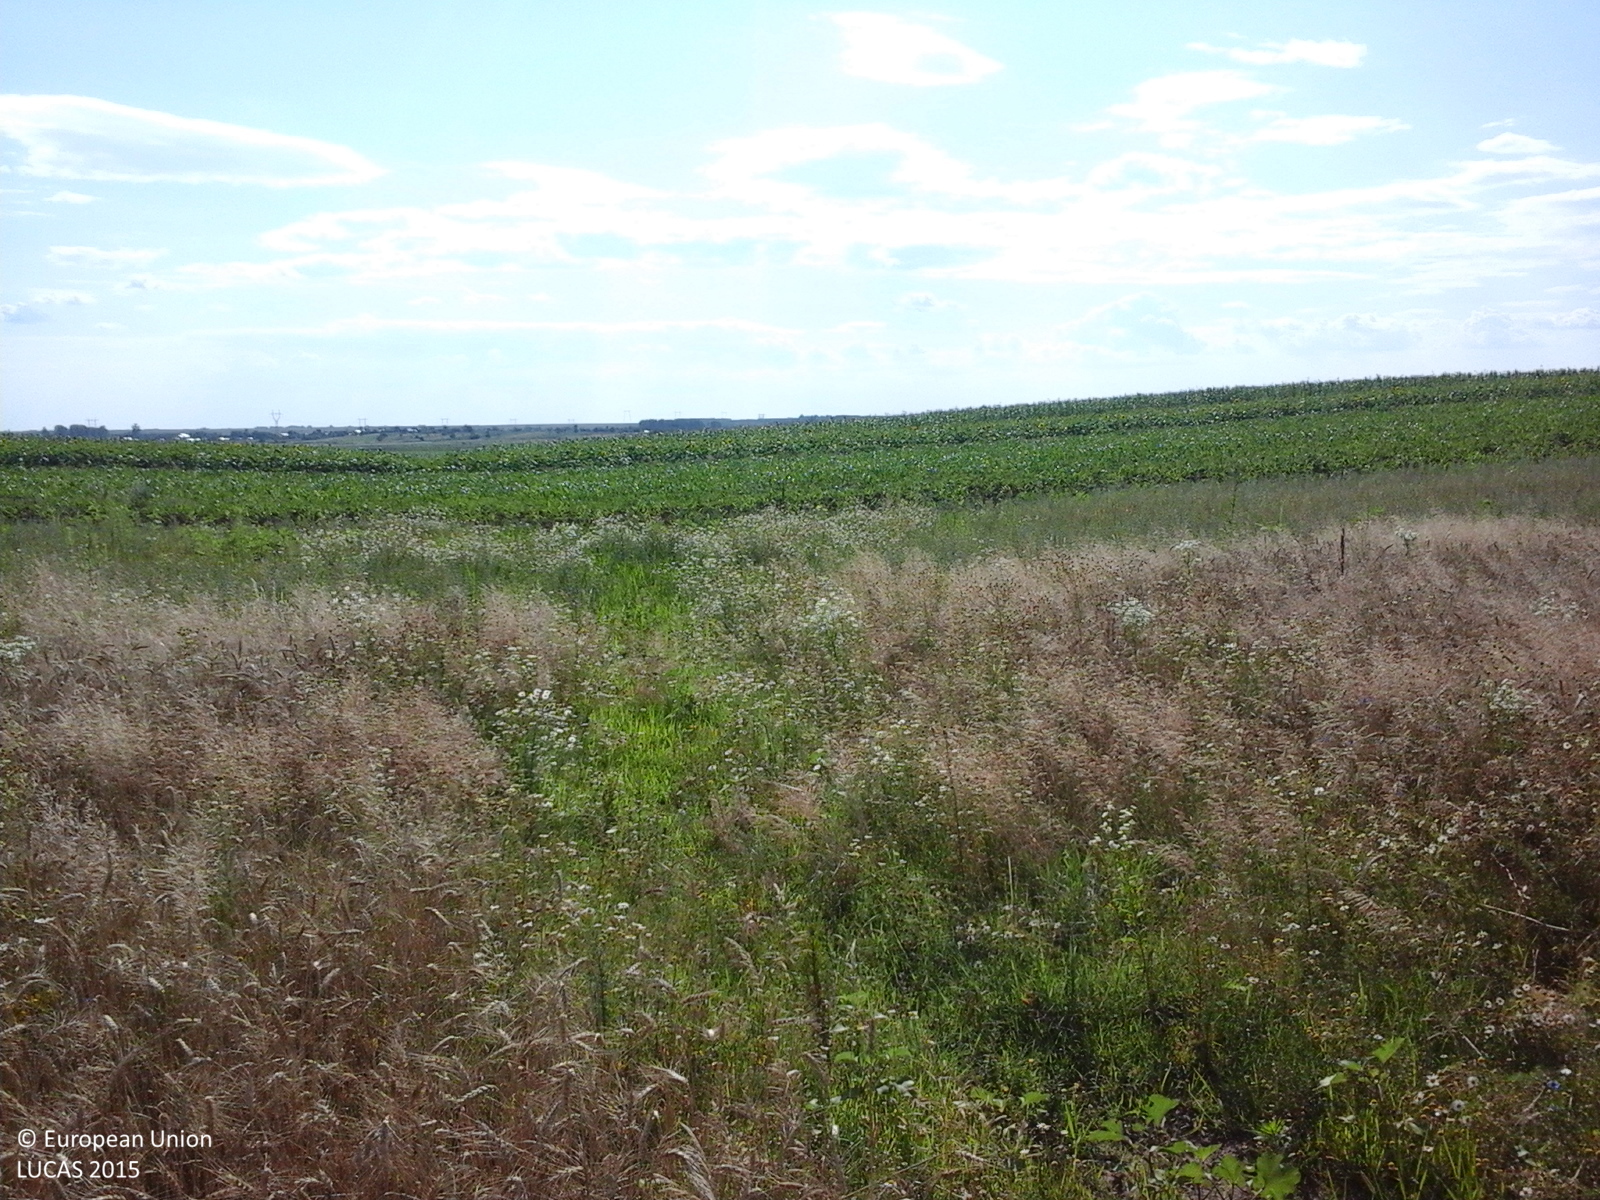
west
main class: Cropland
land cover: Common wheat
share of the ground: > 75 %
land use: Agriculture (excluding fallow land and kitchen gardens)
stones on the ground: < 10 %
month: July
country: RO
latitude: 44.3248
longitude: 24.8094
